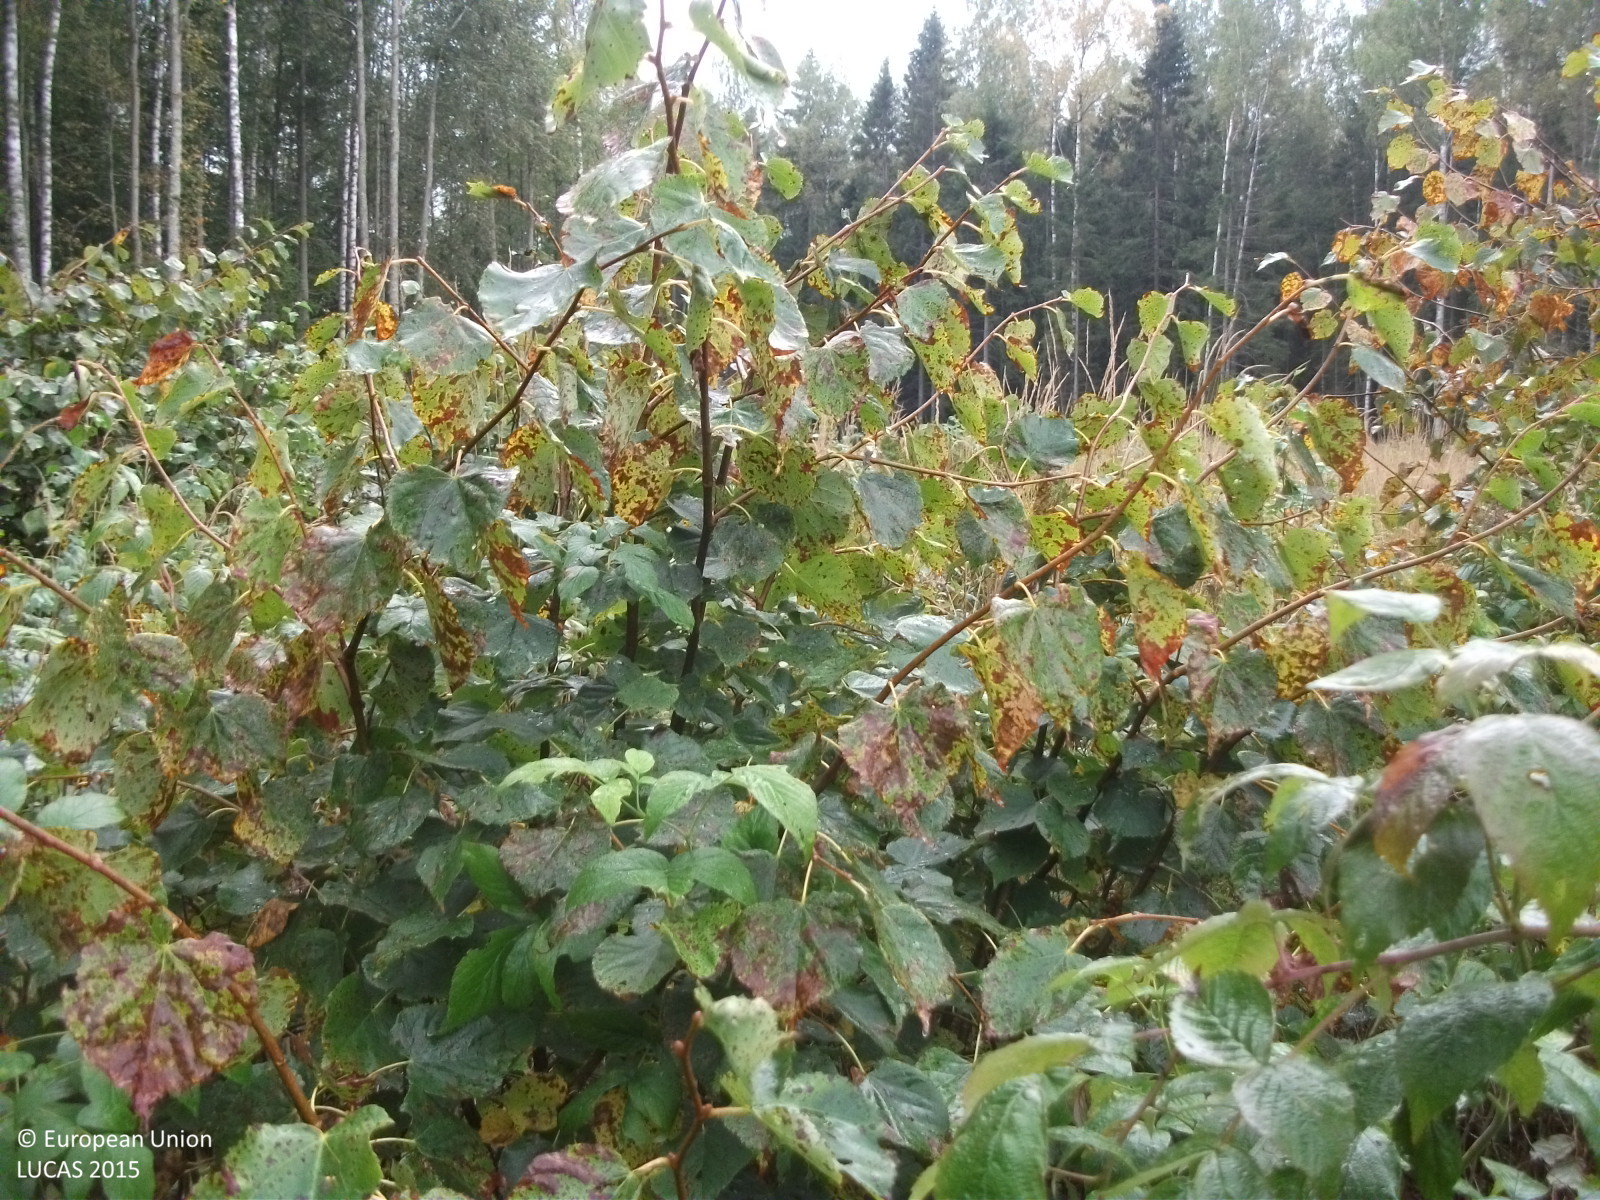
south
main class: Shrubland
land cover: Shrubland with sparse tree cover
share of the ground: > 75 %
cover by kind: shrubs 70 %, herbaceous plants 25 %, broadleaved forest trees 5 %
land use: Forestry
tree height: < 5 m
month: September
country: LV
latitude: 57.7403
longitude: 24.4850
